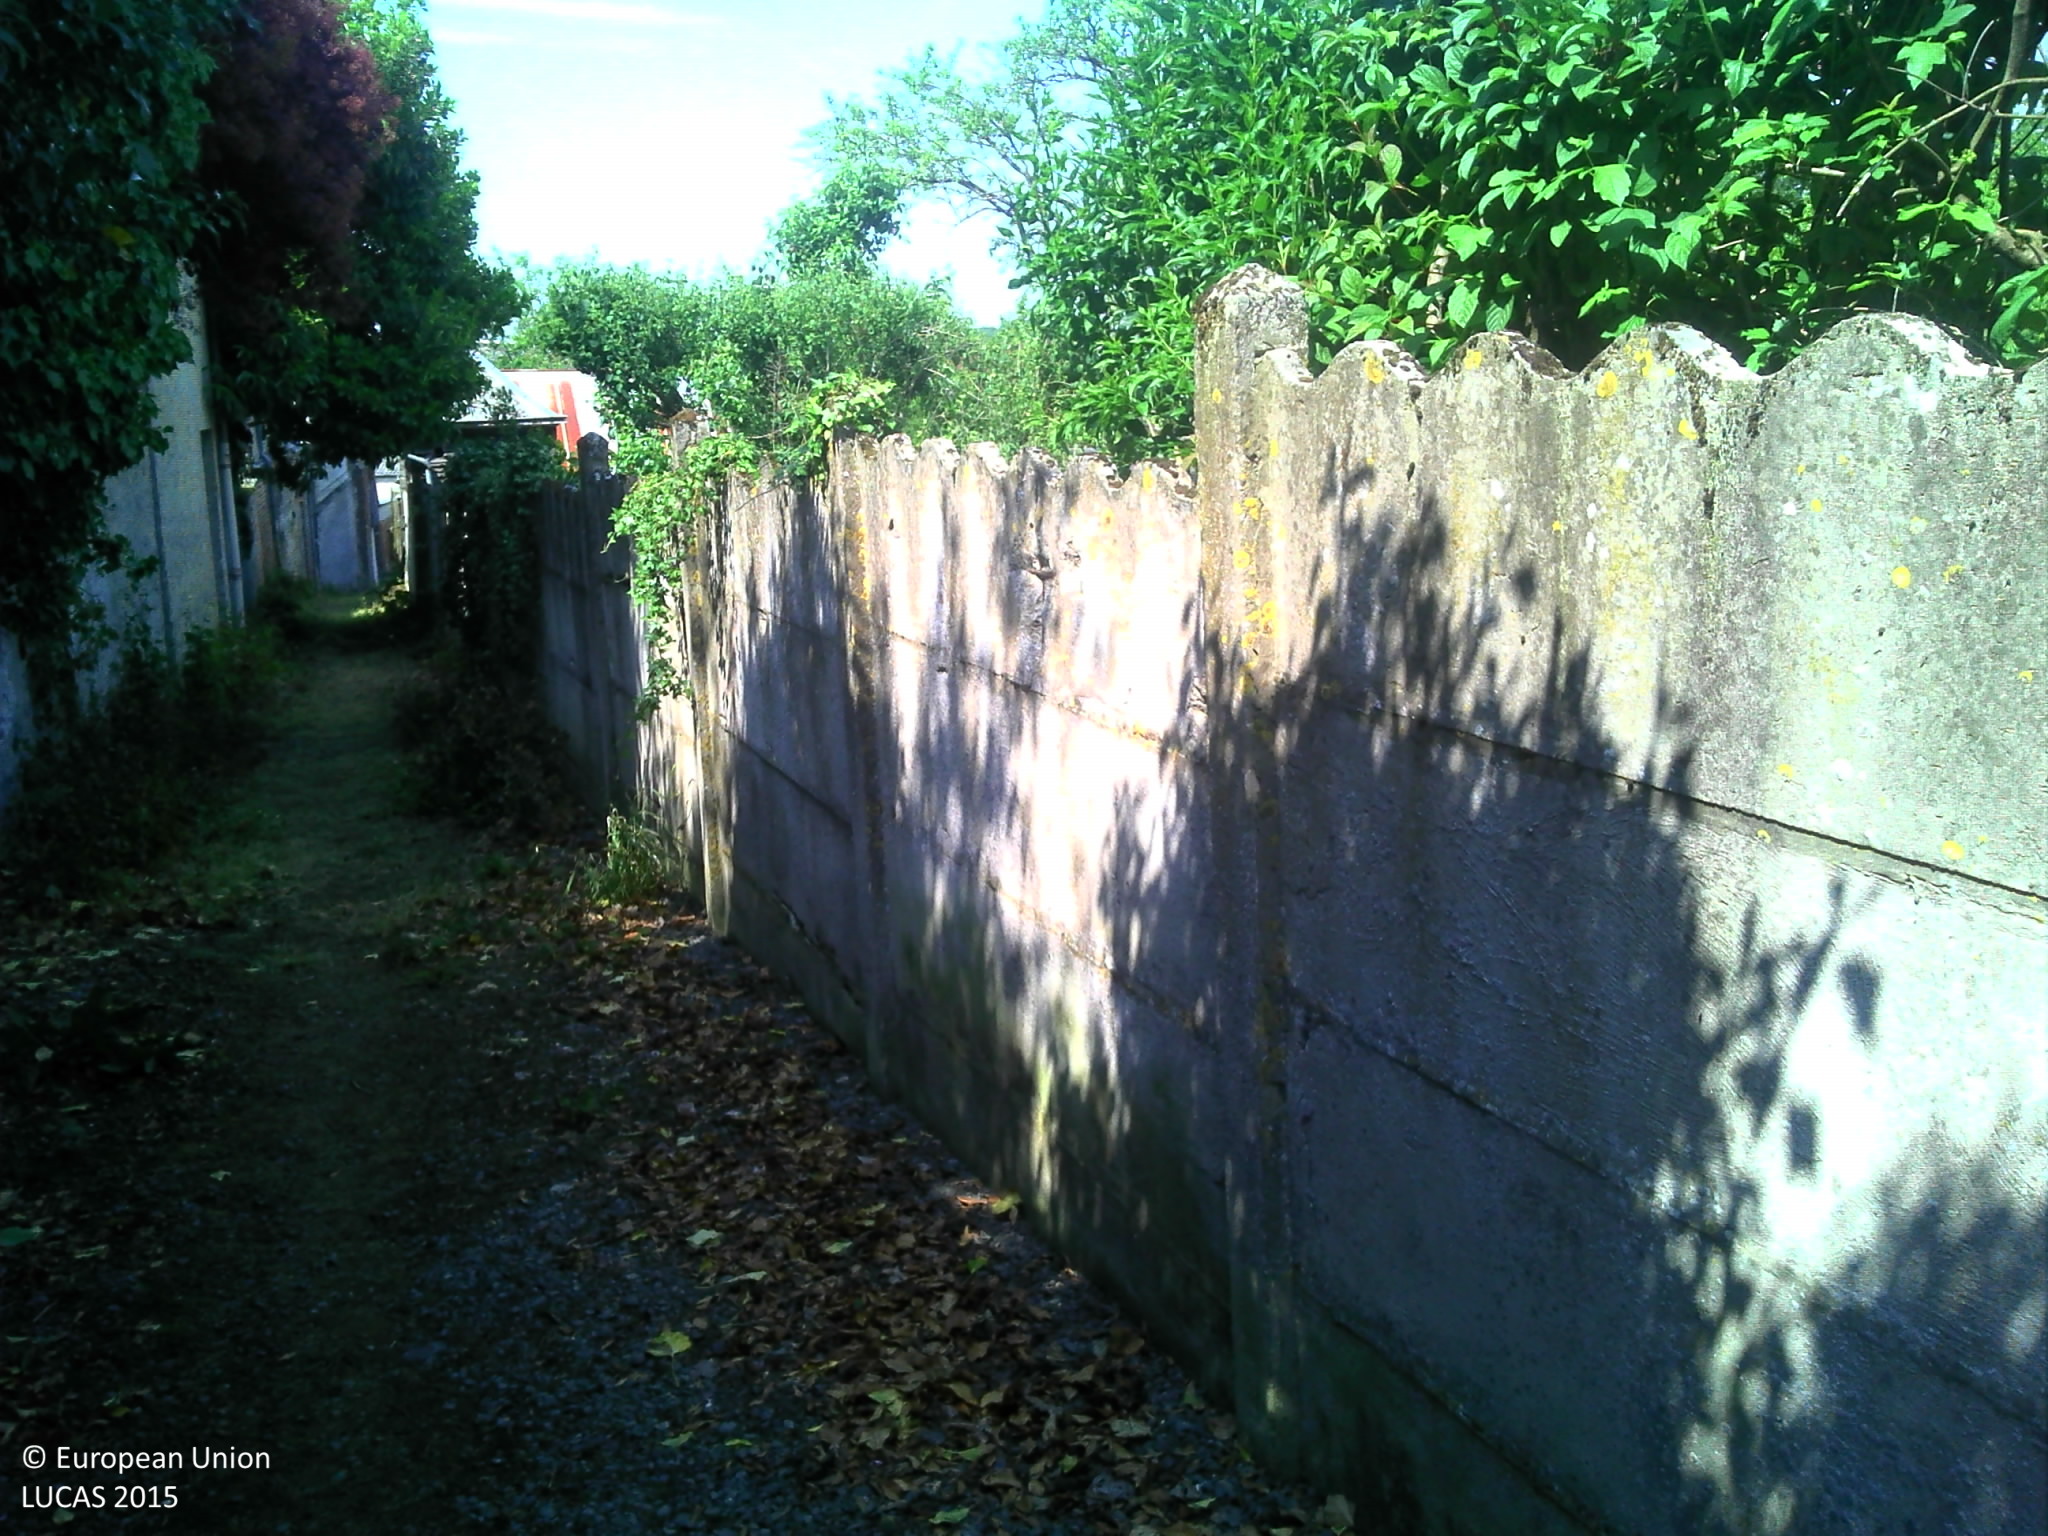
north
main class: Grassland
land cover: Grassland with sparse tree/shrub cover
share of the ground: > 75 %
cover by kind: herbaceous plants 90 %, broadleaved forest trees 5 %, shrubs 5 %
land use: Residential
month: June
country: FR
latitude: 49.7084
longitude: 4.1292
